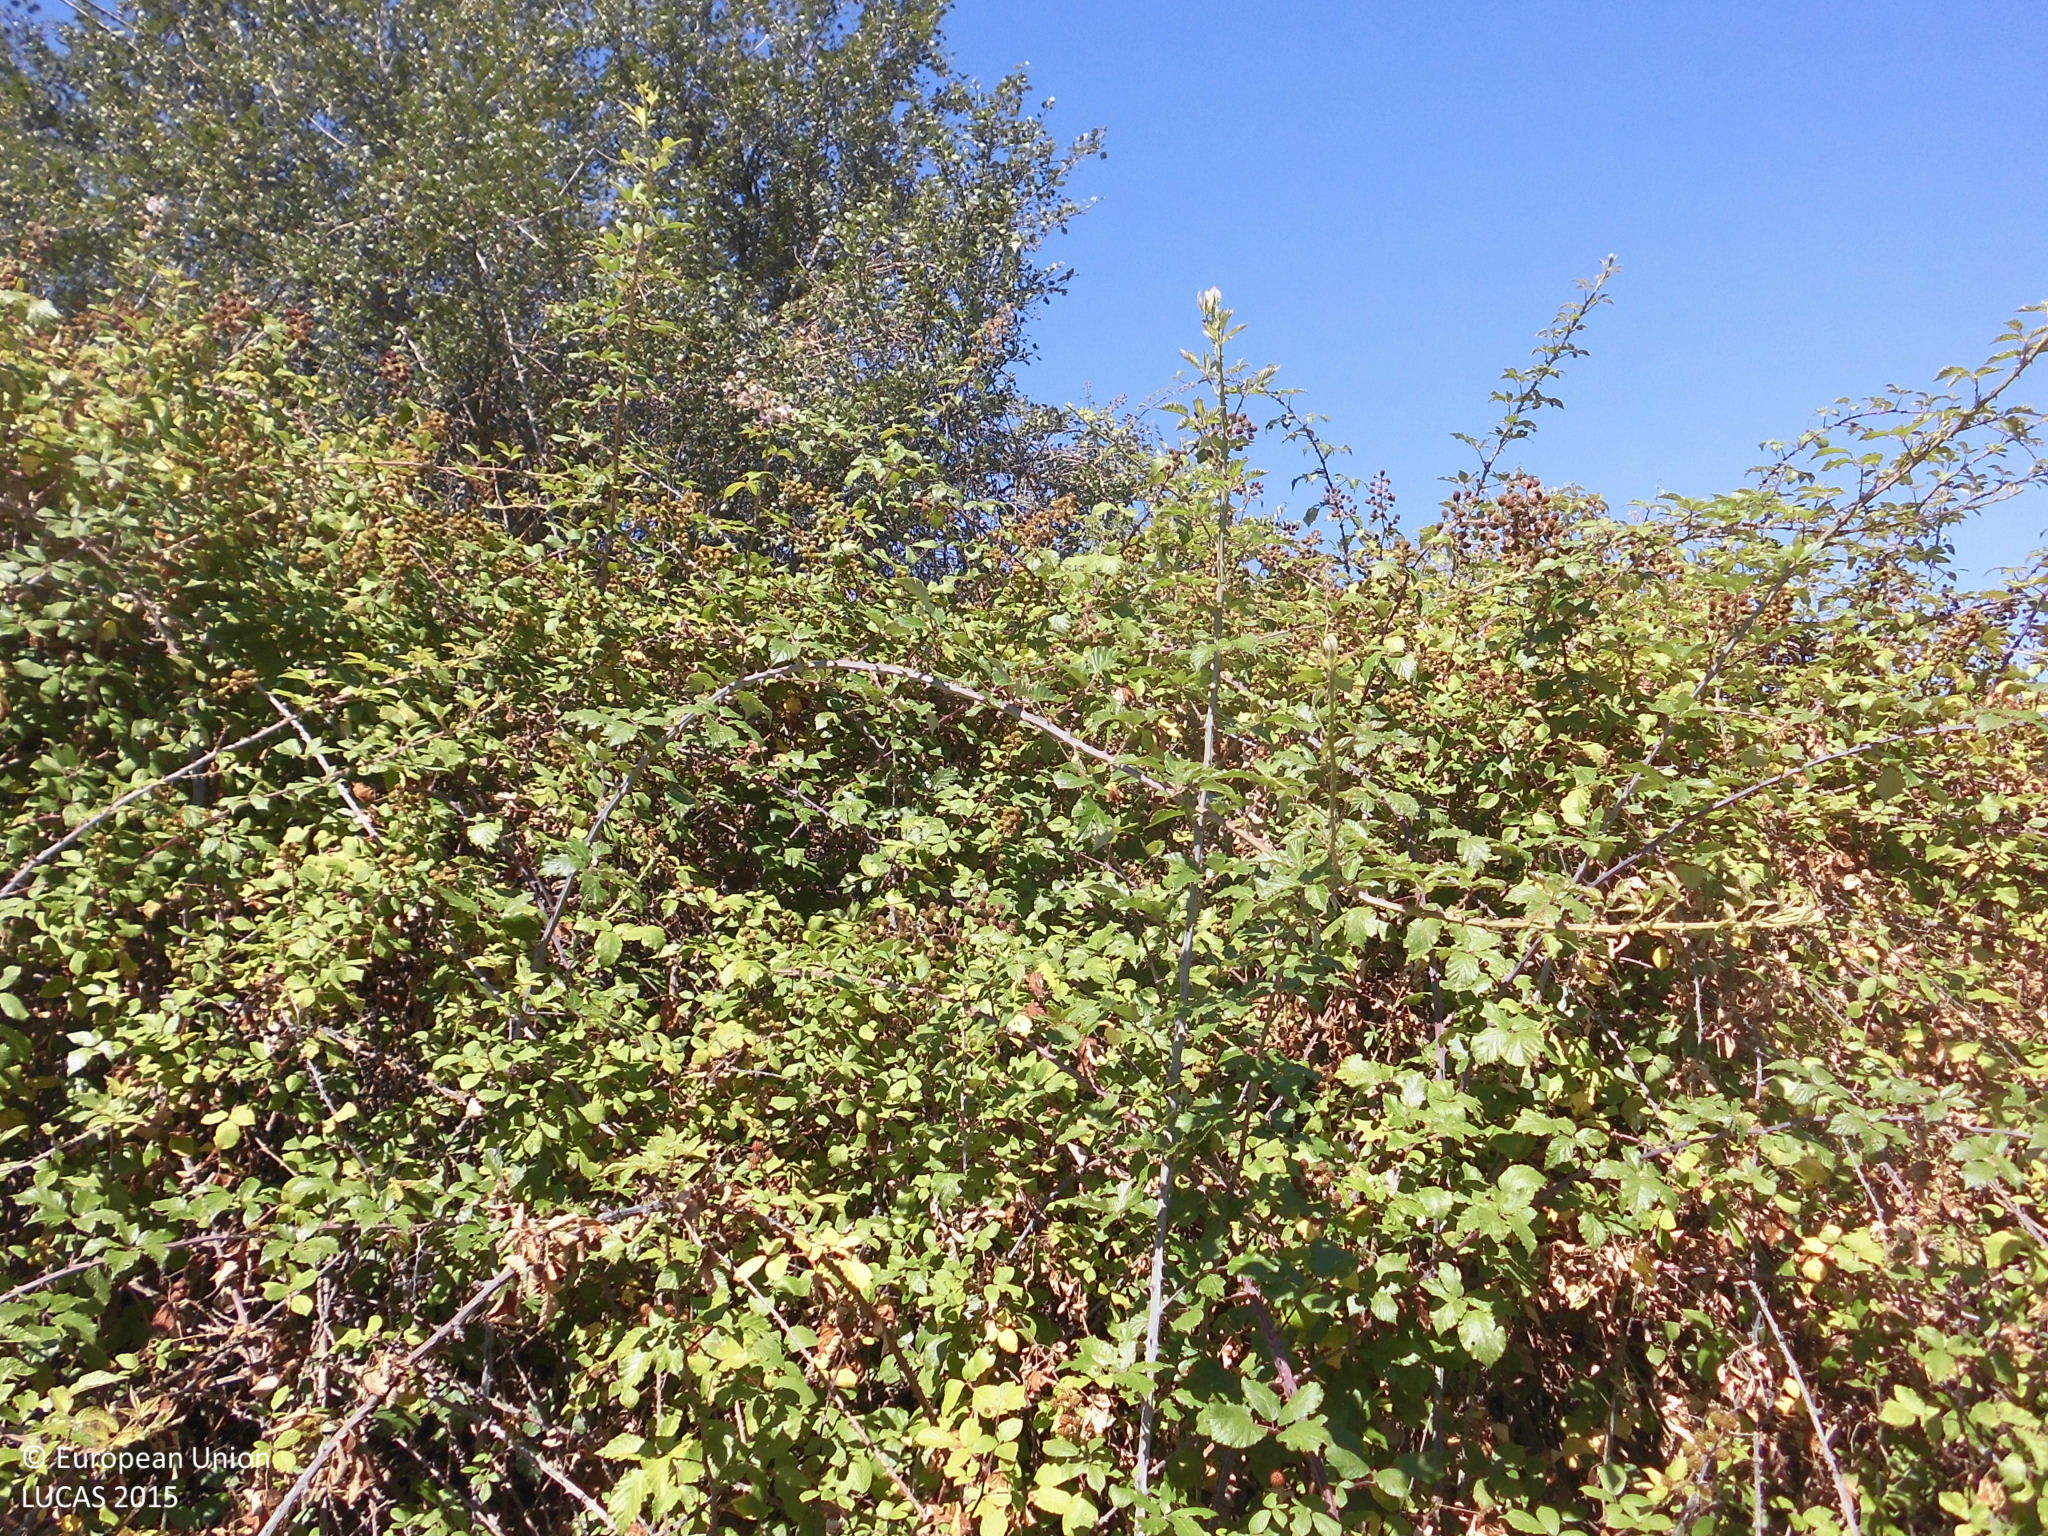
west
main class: Shrubland
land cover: Shrubland with sparse tree cover
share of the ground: > 75 %
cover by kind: herbaceous plants 65 %, shrubs 30 %, broadleaved forest trees 5 %
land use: Semi-natural and natural areas not in use
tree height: > 5 m
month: July
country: ES
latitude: 40.0826
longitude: -6.1279
